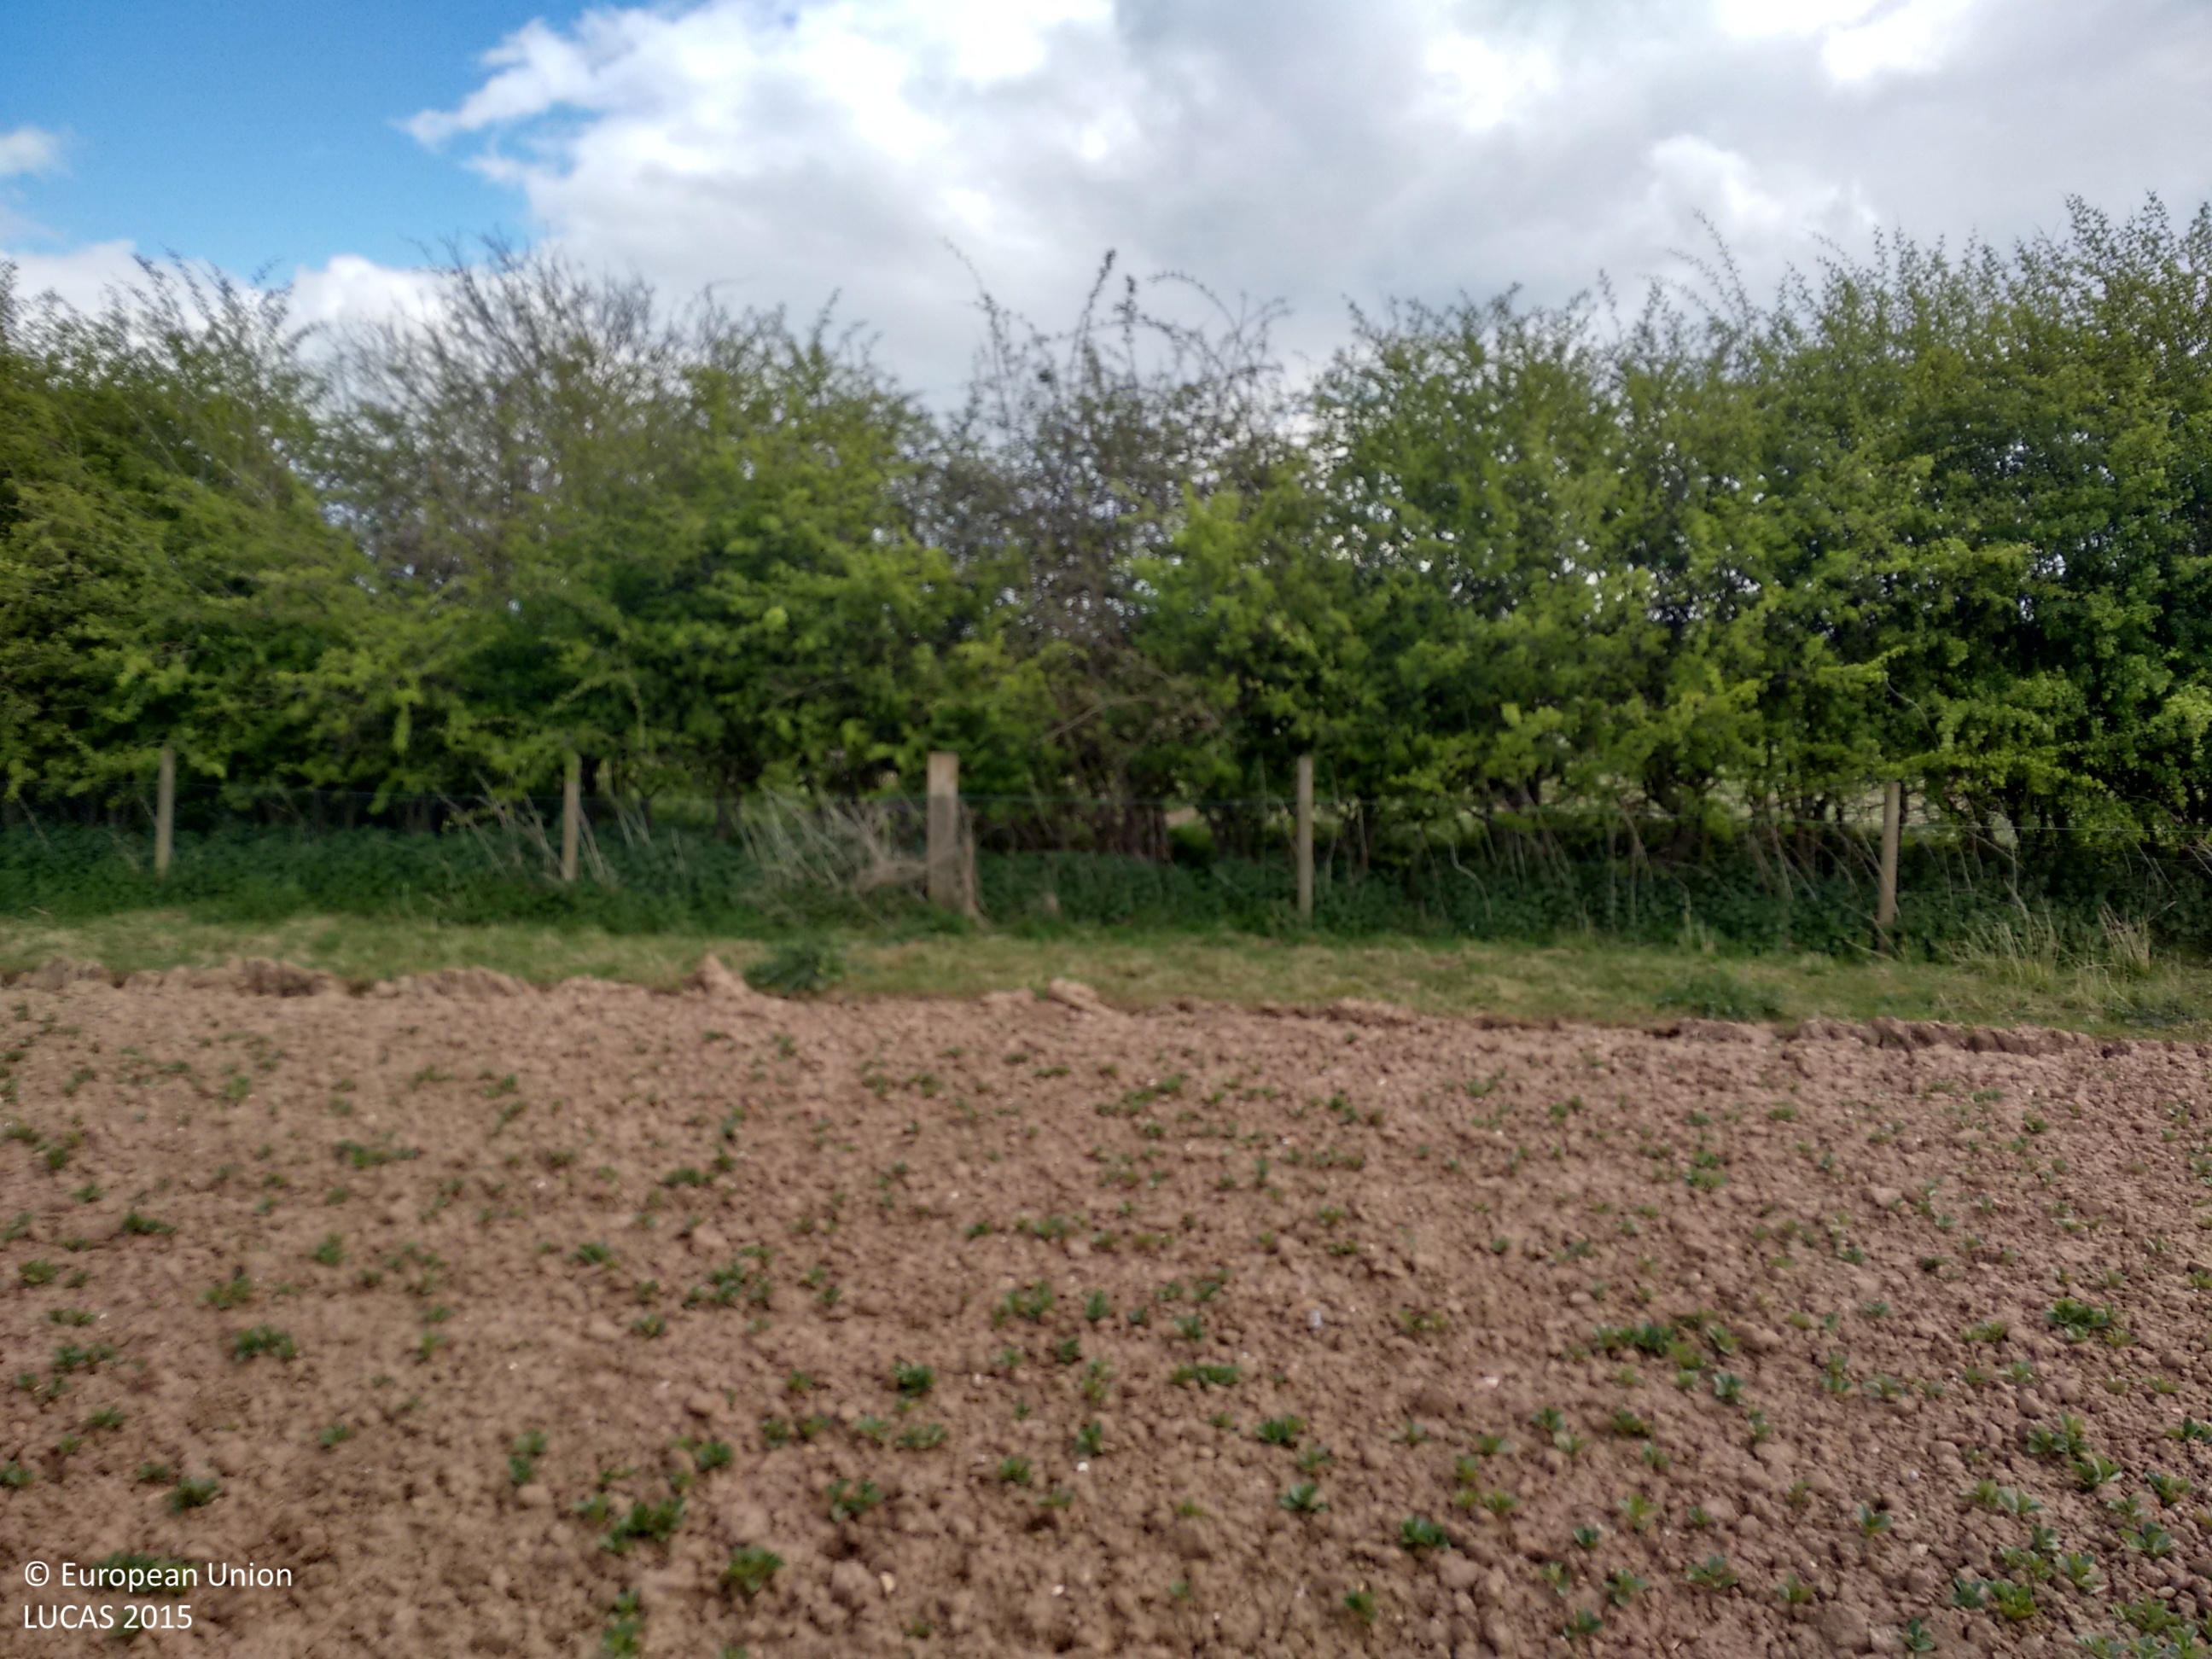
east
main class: Cropland
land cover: Dry pulses
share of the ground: 10 - 25 %
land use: Agriculture (excluding fallow land and kitchen gardens)
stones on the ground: < 10 %
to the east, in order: Dry pulses; Fences; Managed hedges; Grass margins; Tracks; Spontaneously vegetated surfaces; Managed hedges; Fences; Barley; Fences; Managed hedges; Other bare soil; Managed hedges; Grass margins; Paved roads, cycling and walking lanes; Grass margins
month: April
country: GB
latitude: 54.0150
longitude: -0.4903
